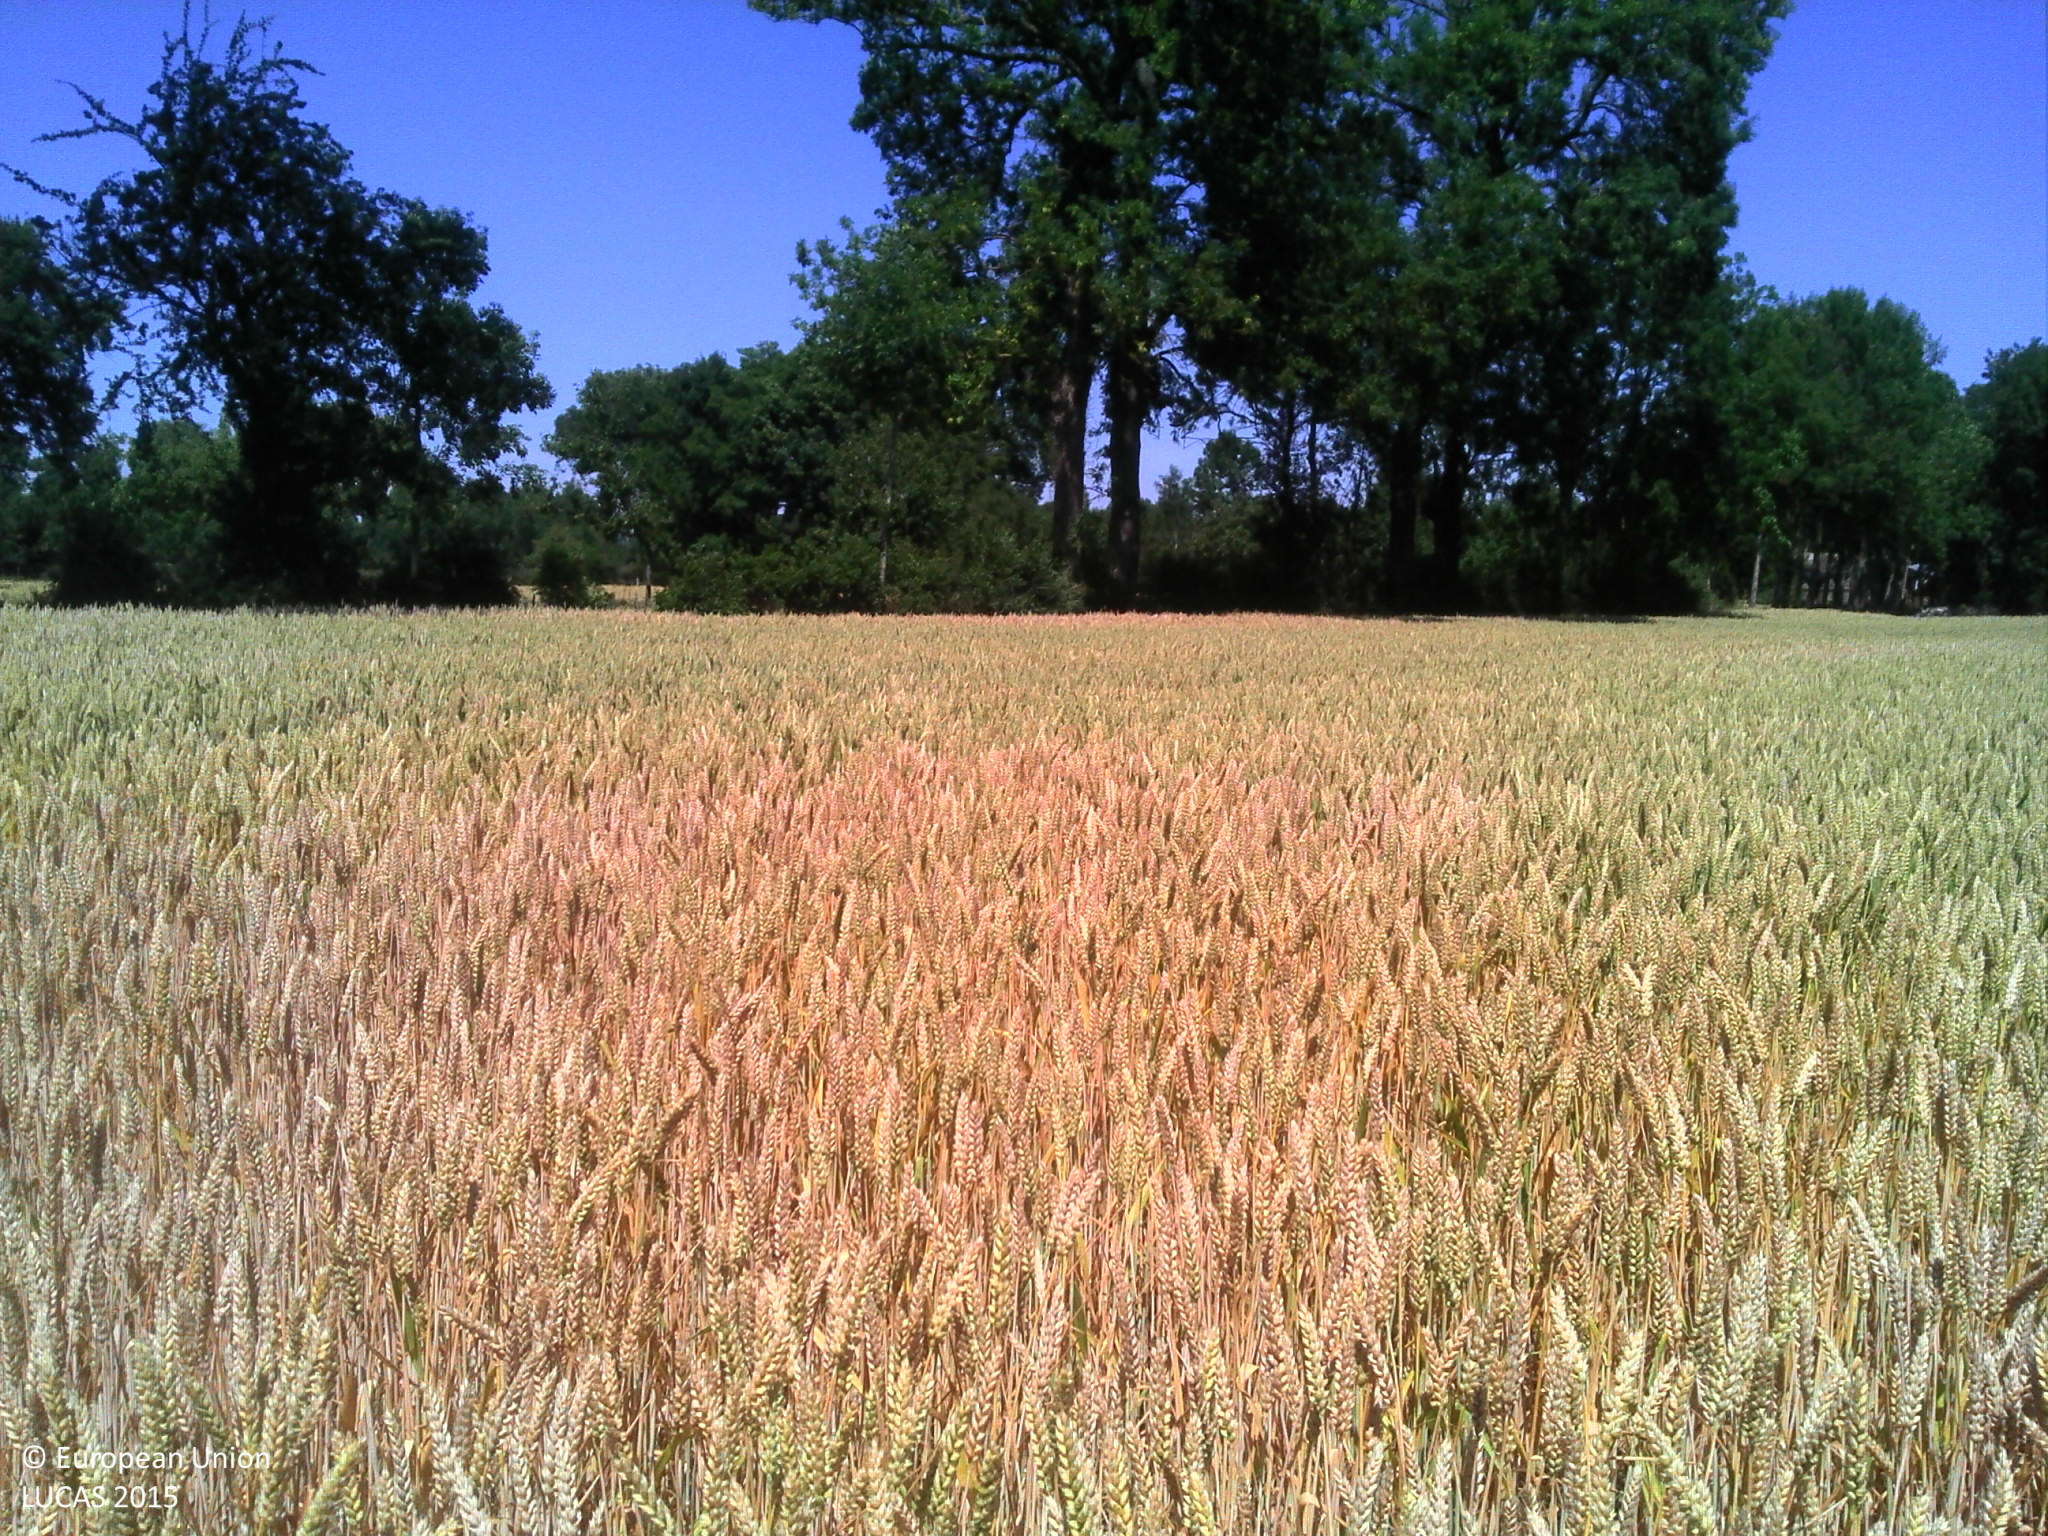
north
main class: Cropland
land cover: Common wheat
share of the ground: > 75 %
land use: Agriculture (excluding fallow land and kitchen gardens)
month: July
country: FR
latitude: 49.9370
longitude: 1.7205
